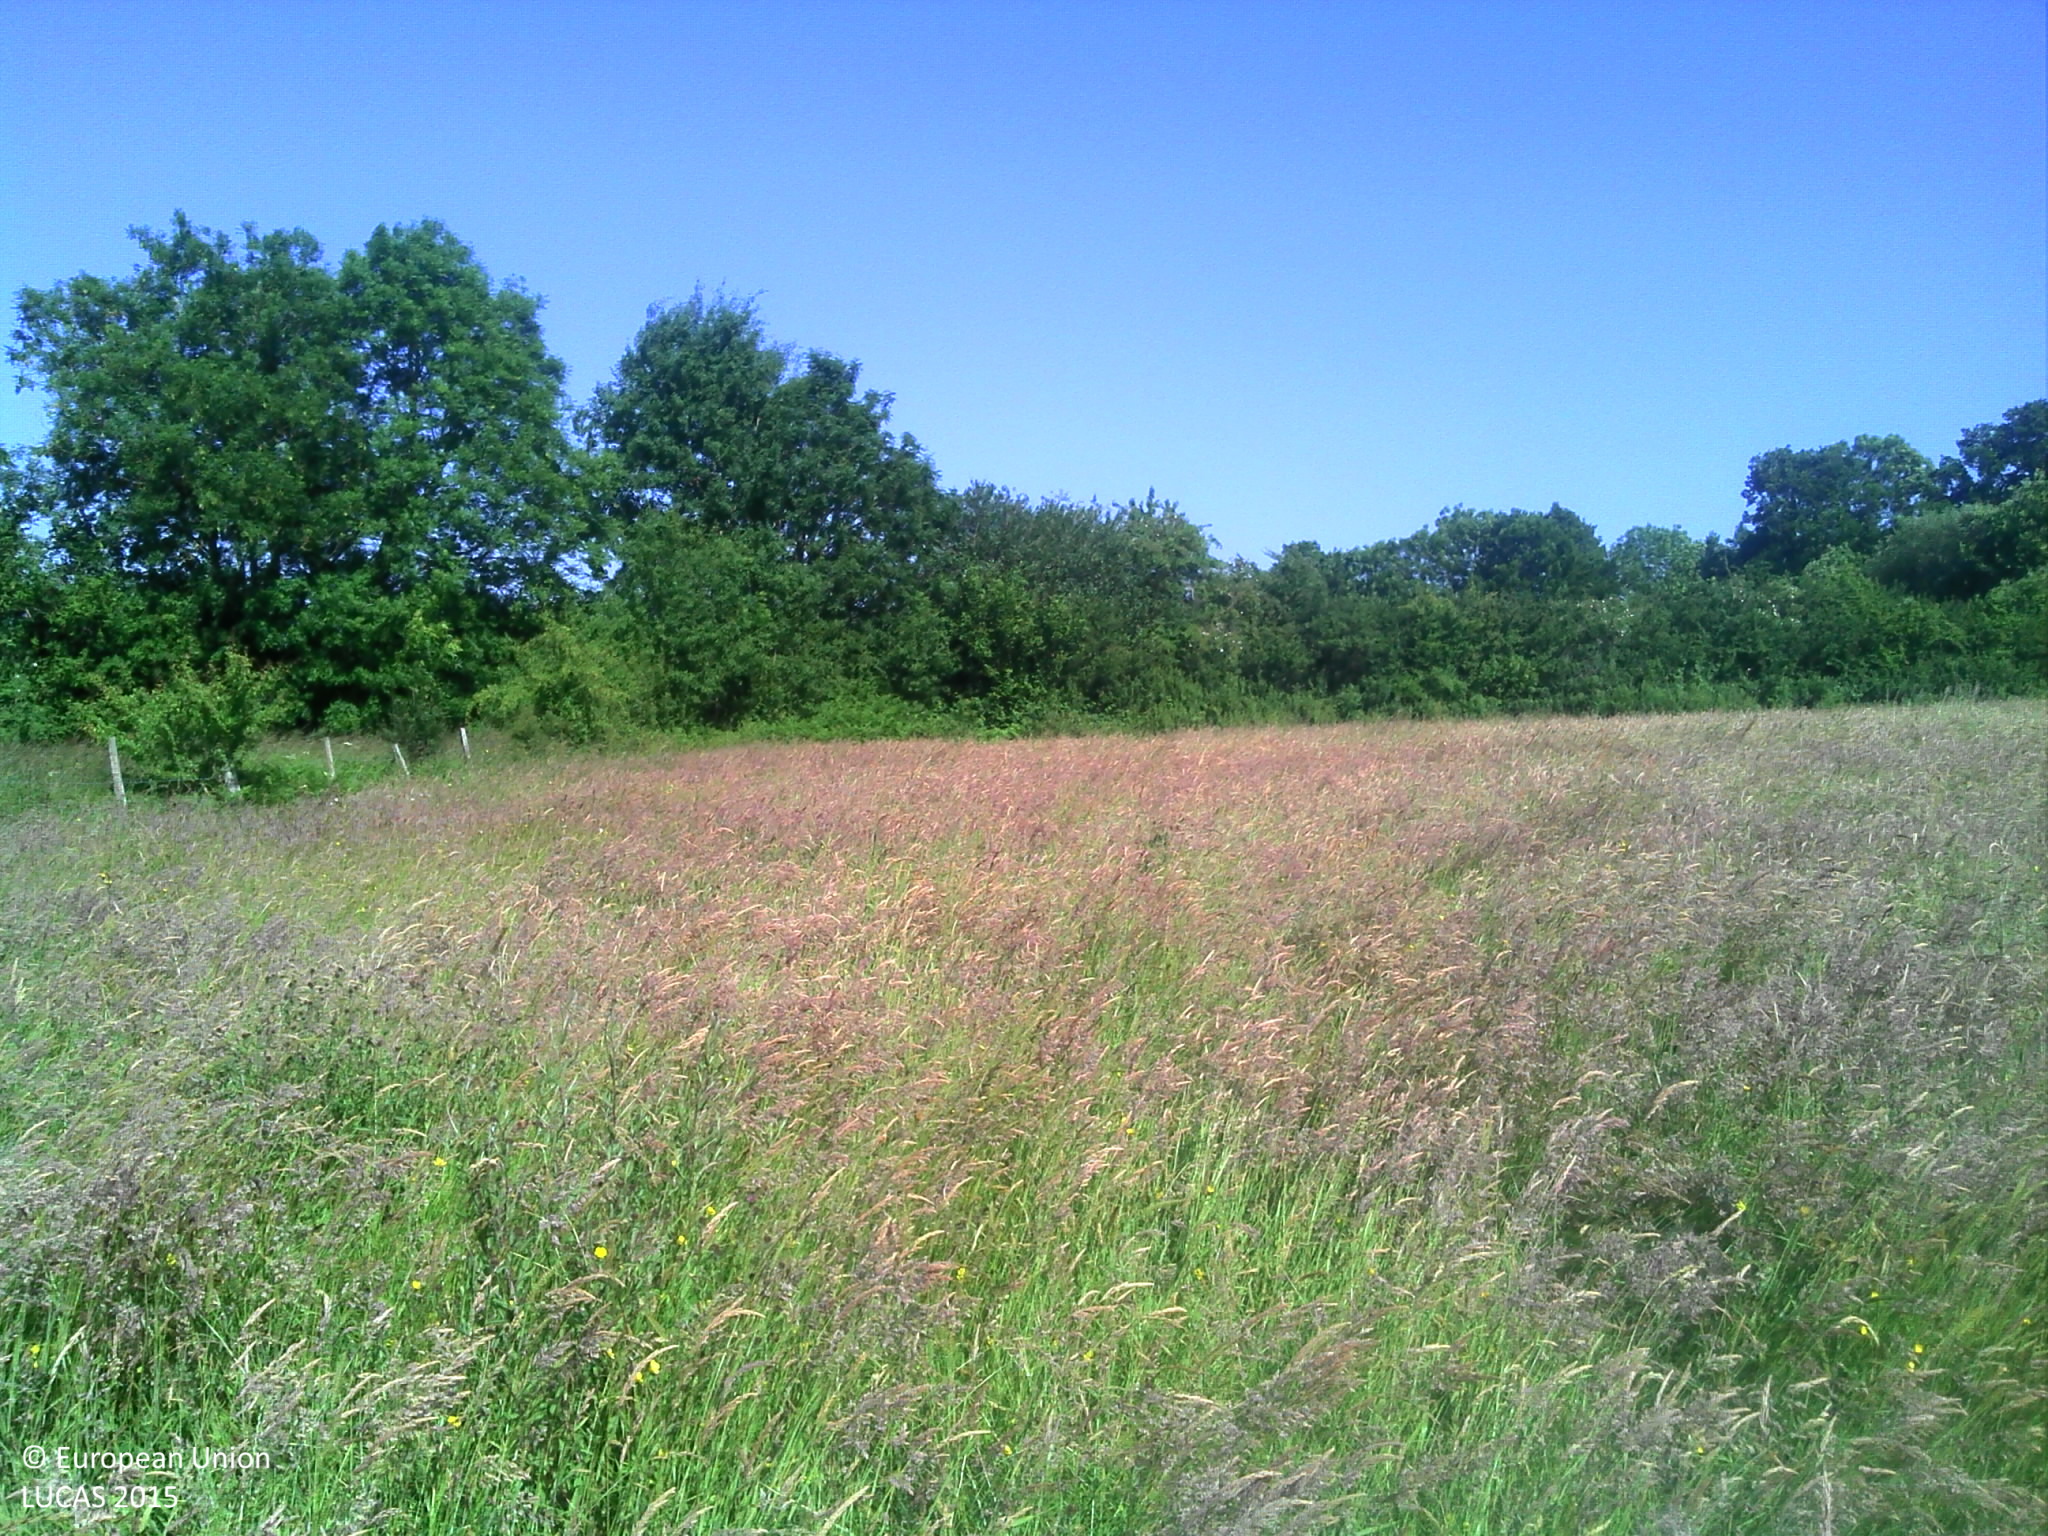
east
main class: Grassland
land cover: Grassland without tree/shrub cover
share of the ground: > 75 %
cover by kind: herbaceous plants 100 %
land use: Agriculture (excluding fallow land and kitchen gardens)
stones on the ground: < 10 %
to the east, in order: Grassland without tree/shrub cover; Broadleaved woodland; Grass margins; Durum wheat; Grass margins; Broadleaved woodland; Ditches and canals; Grassland with sparse tree/shrub cover; Grassland without tree/shrub cover; Broadleaved woodland; Fences
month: June
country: FR
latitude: 48.5921
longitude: -0.1047
